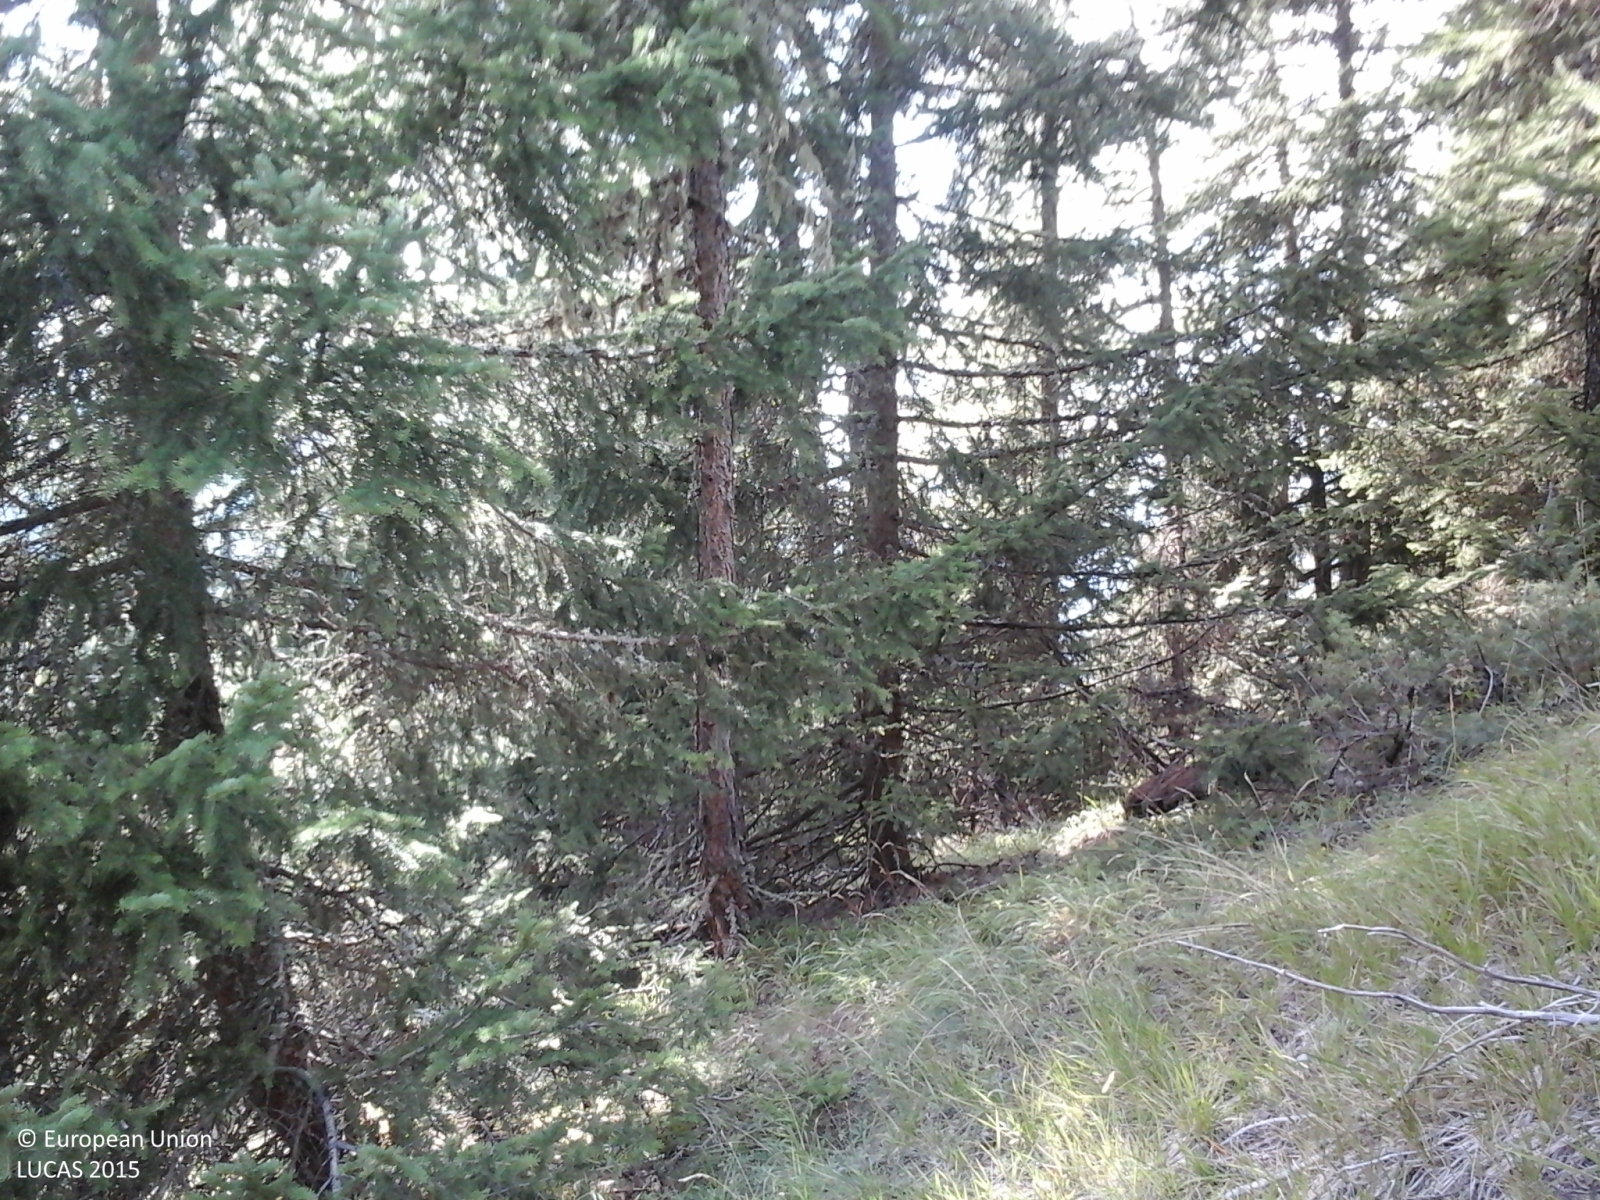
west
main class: Woodland
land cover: Spruce dominated coniferous woodland
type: alpine coniferous forest
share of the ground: > 75 %
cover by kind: coniferous forest trees 100 %
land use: Forestry
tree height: > 5 m
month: August
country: IT
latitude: 45.6668
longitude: 7.2442
